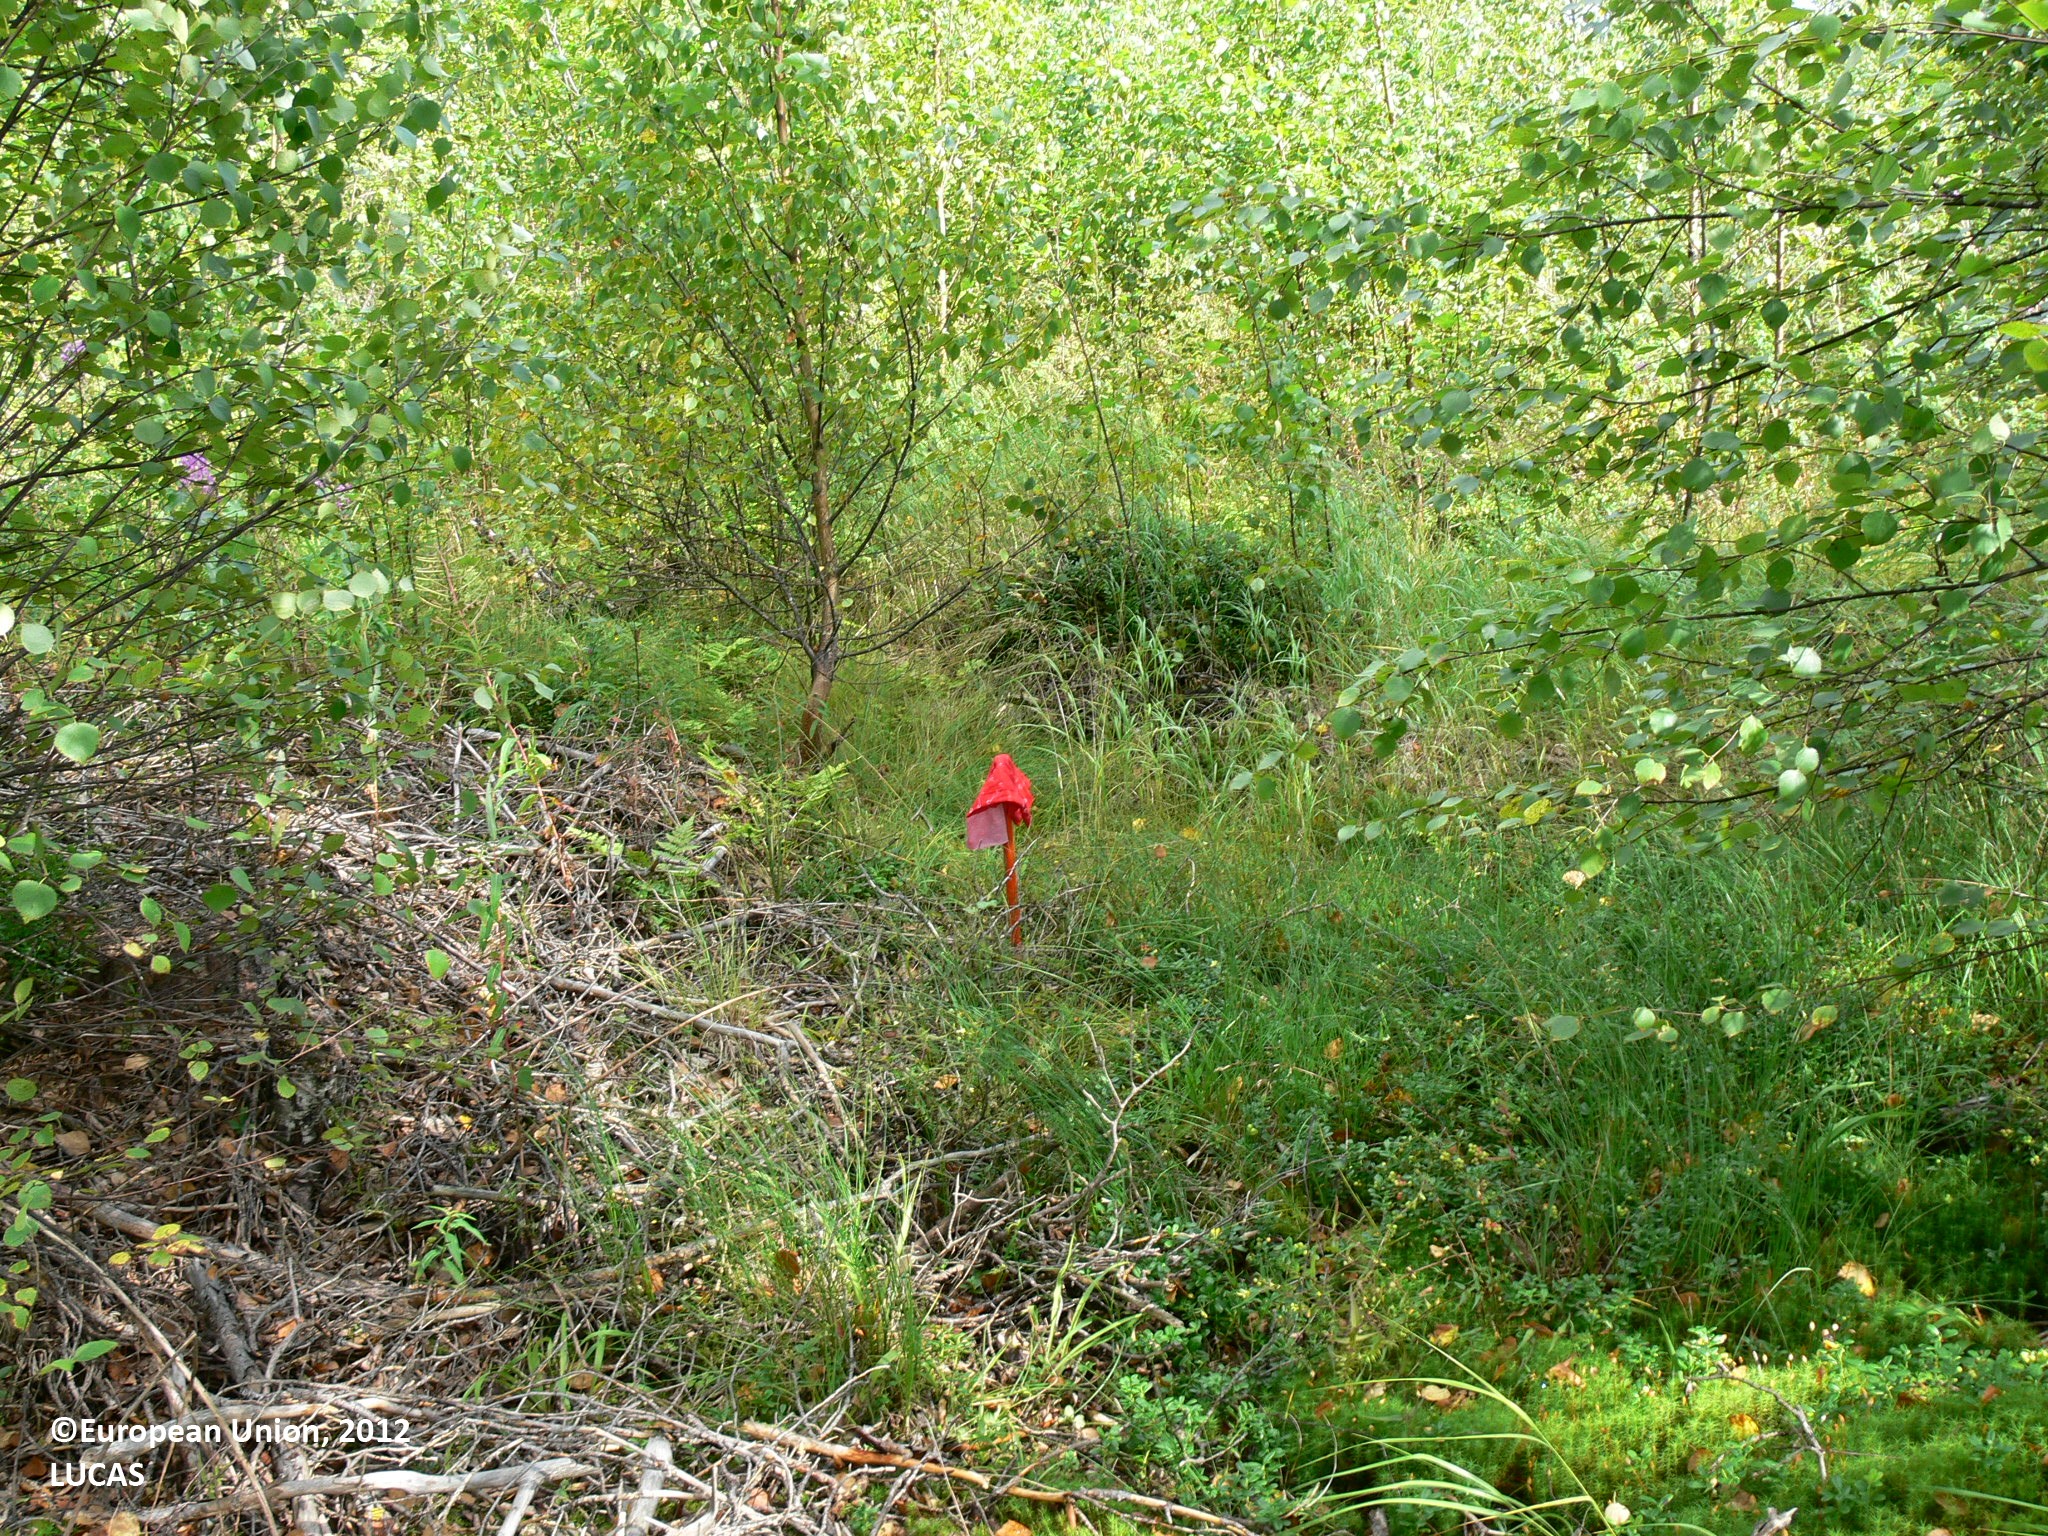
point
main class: Woodland
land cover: Broadleaved woodland
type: boreal forest
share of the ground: 50 - 75 %
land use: Forestry
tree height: < 5 m
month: August
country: FI
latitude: 61.8871
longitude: 29.2800
